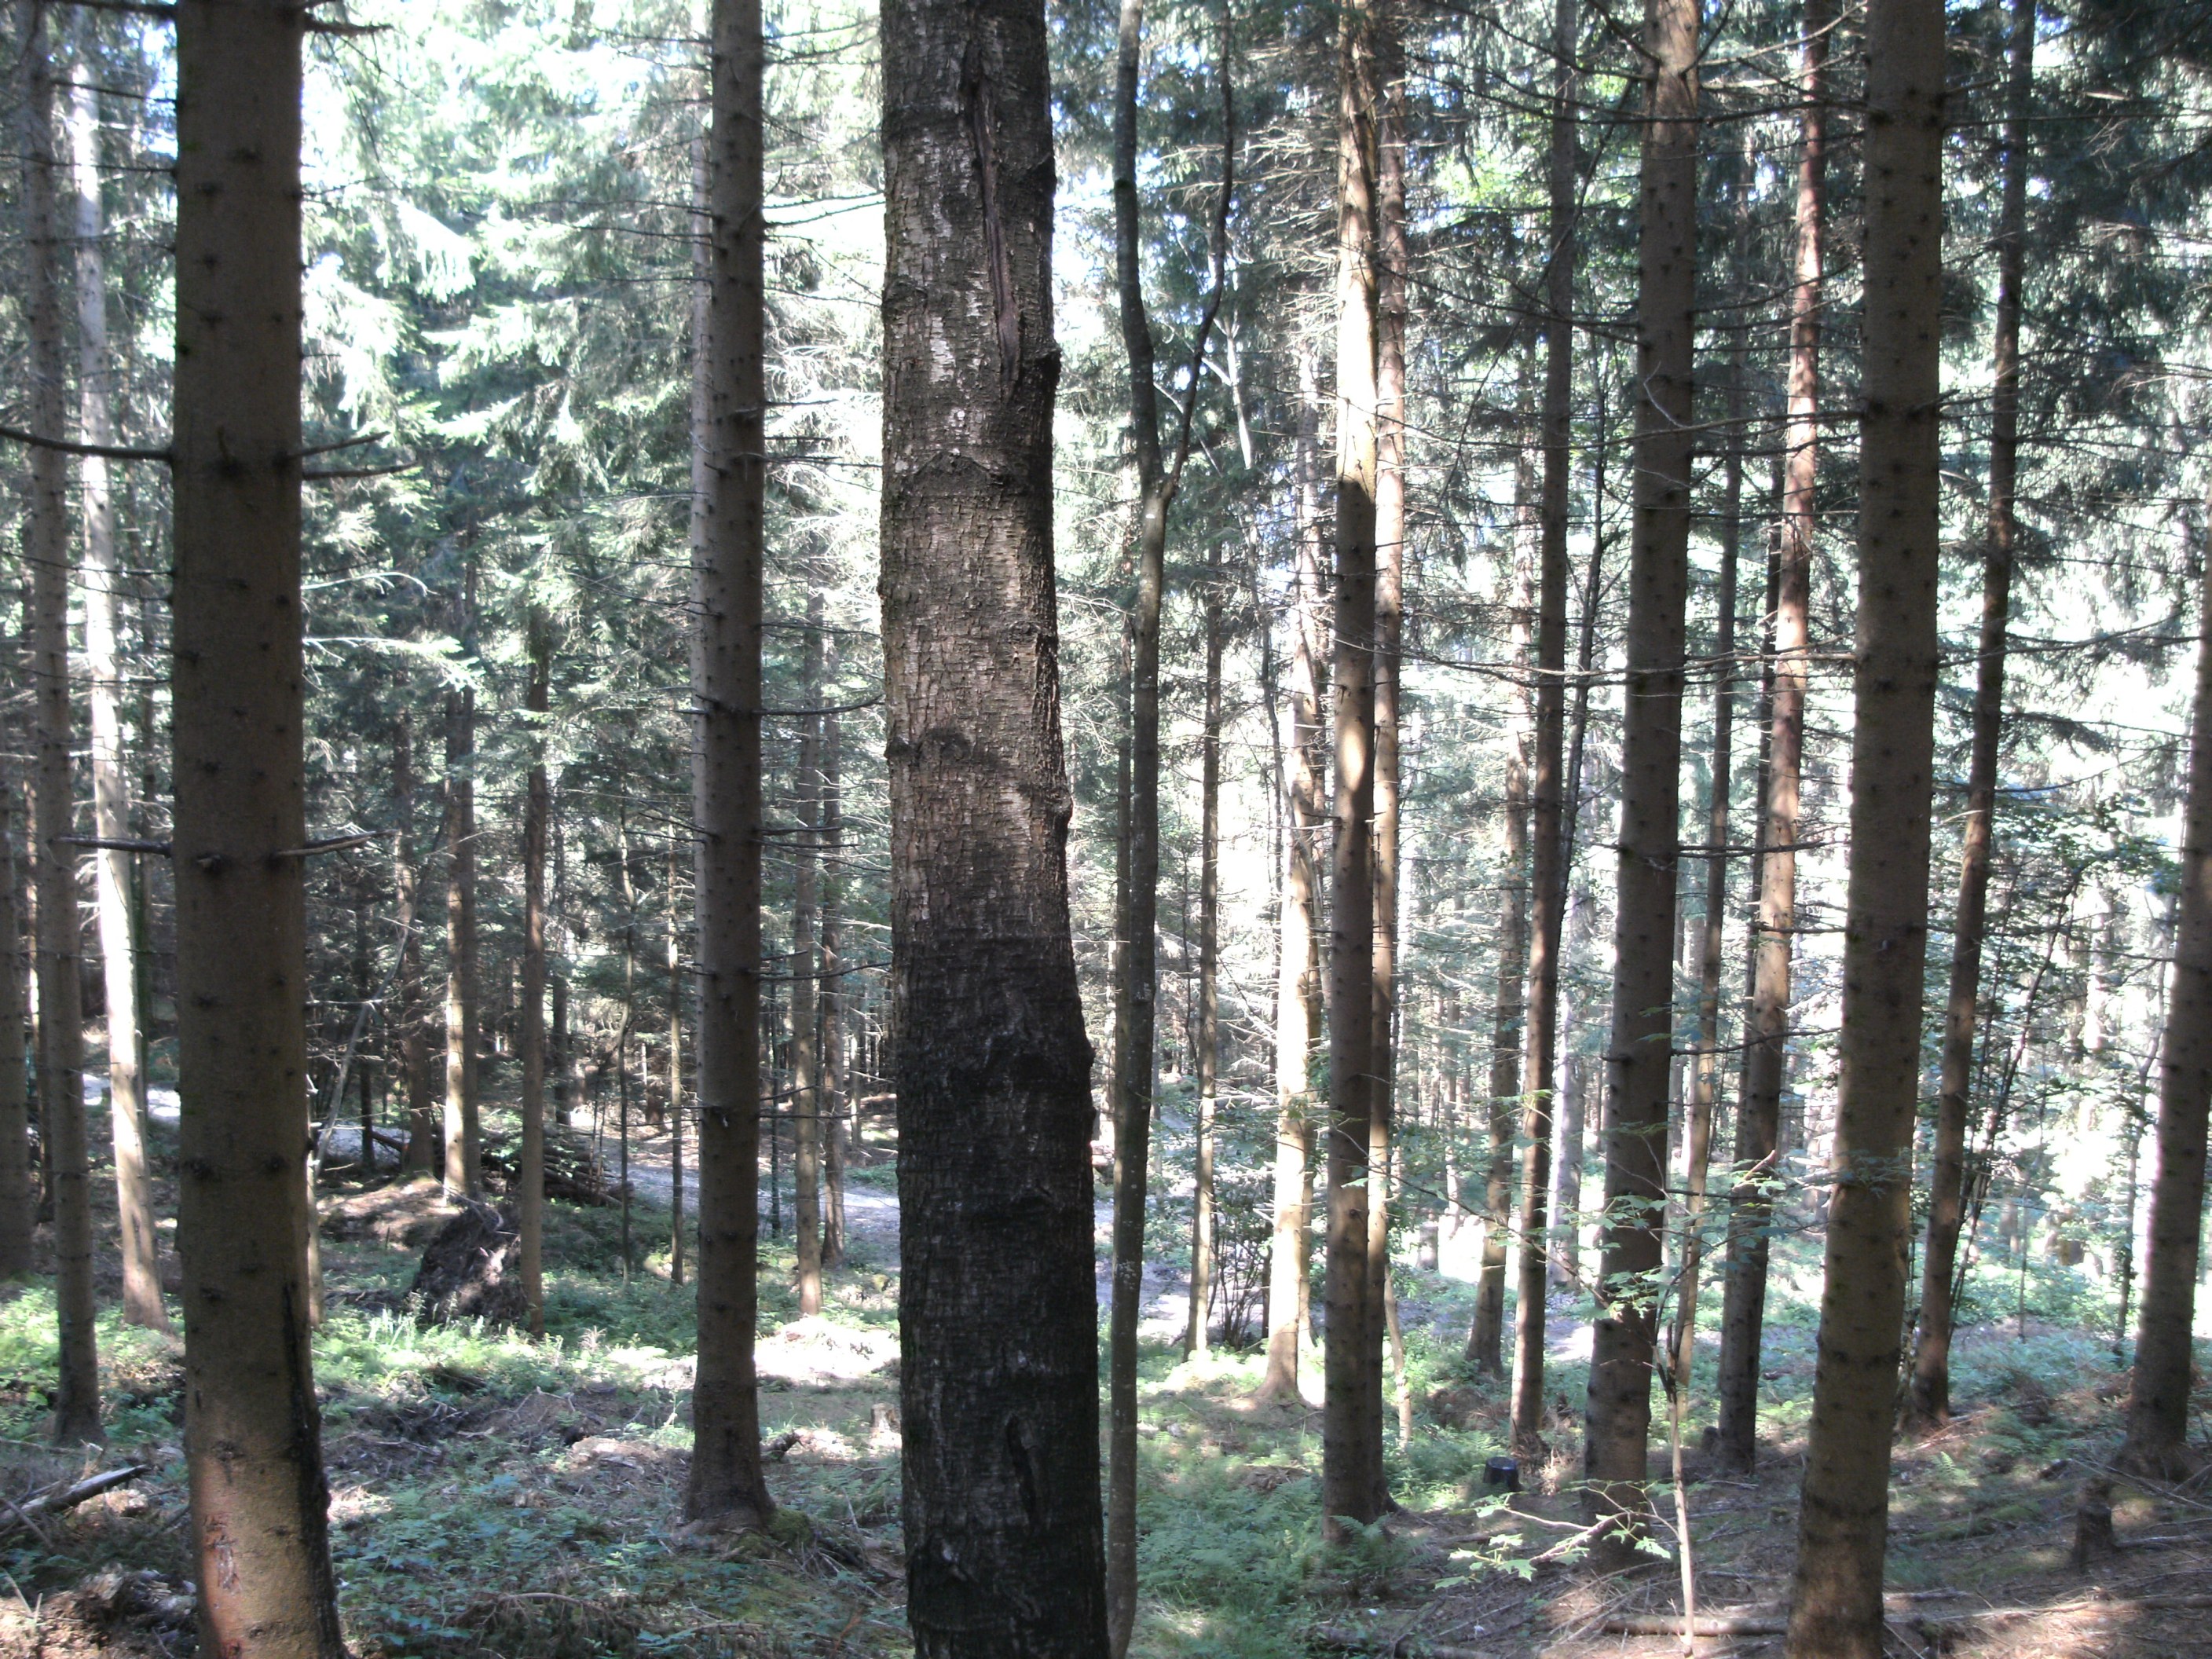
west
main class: Woodland
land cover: Spruce dominated coniferous woodland
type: alpine coniferous forest
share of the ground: > 75 %
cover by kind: coniferous forest trees 75 %, unconsolidated bare surface 10 %, broadleaved forest trees 5 %, shrubs 5 %, herbaceous plants 5 %
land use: Forestry
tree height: > 5 m
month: July
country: AT
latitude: 46.8348
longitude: 14.8888
